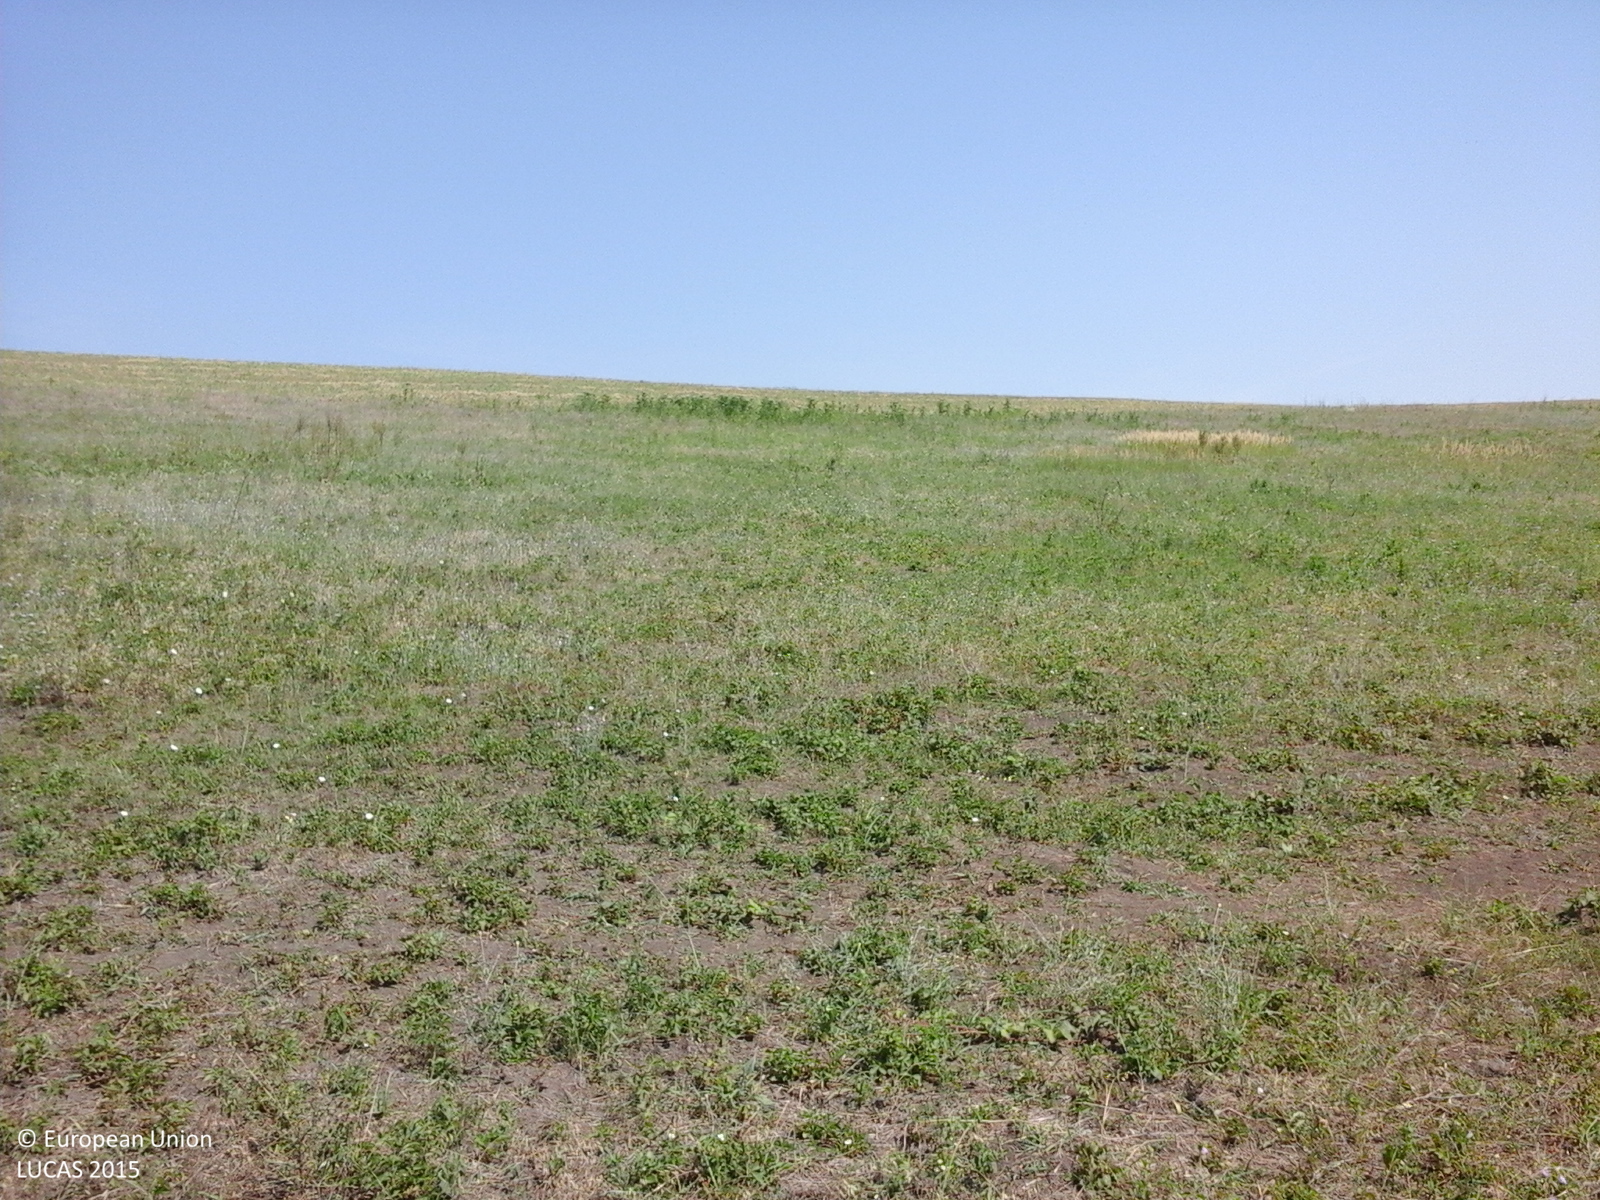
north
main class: Grassland
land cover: Grassland without tree/shrub cover
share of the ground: > 75 %
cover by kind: herbaceous plants 100 %
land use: Agriculture (excluding fallow land and kitchen gardens)
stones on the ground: < 10 %
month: July
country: RO
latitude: 46.1078
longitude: 27.5089
